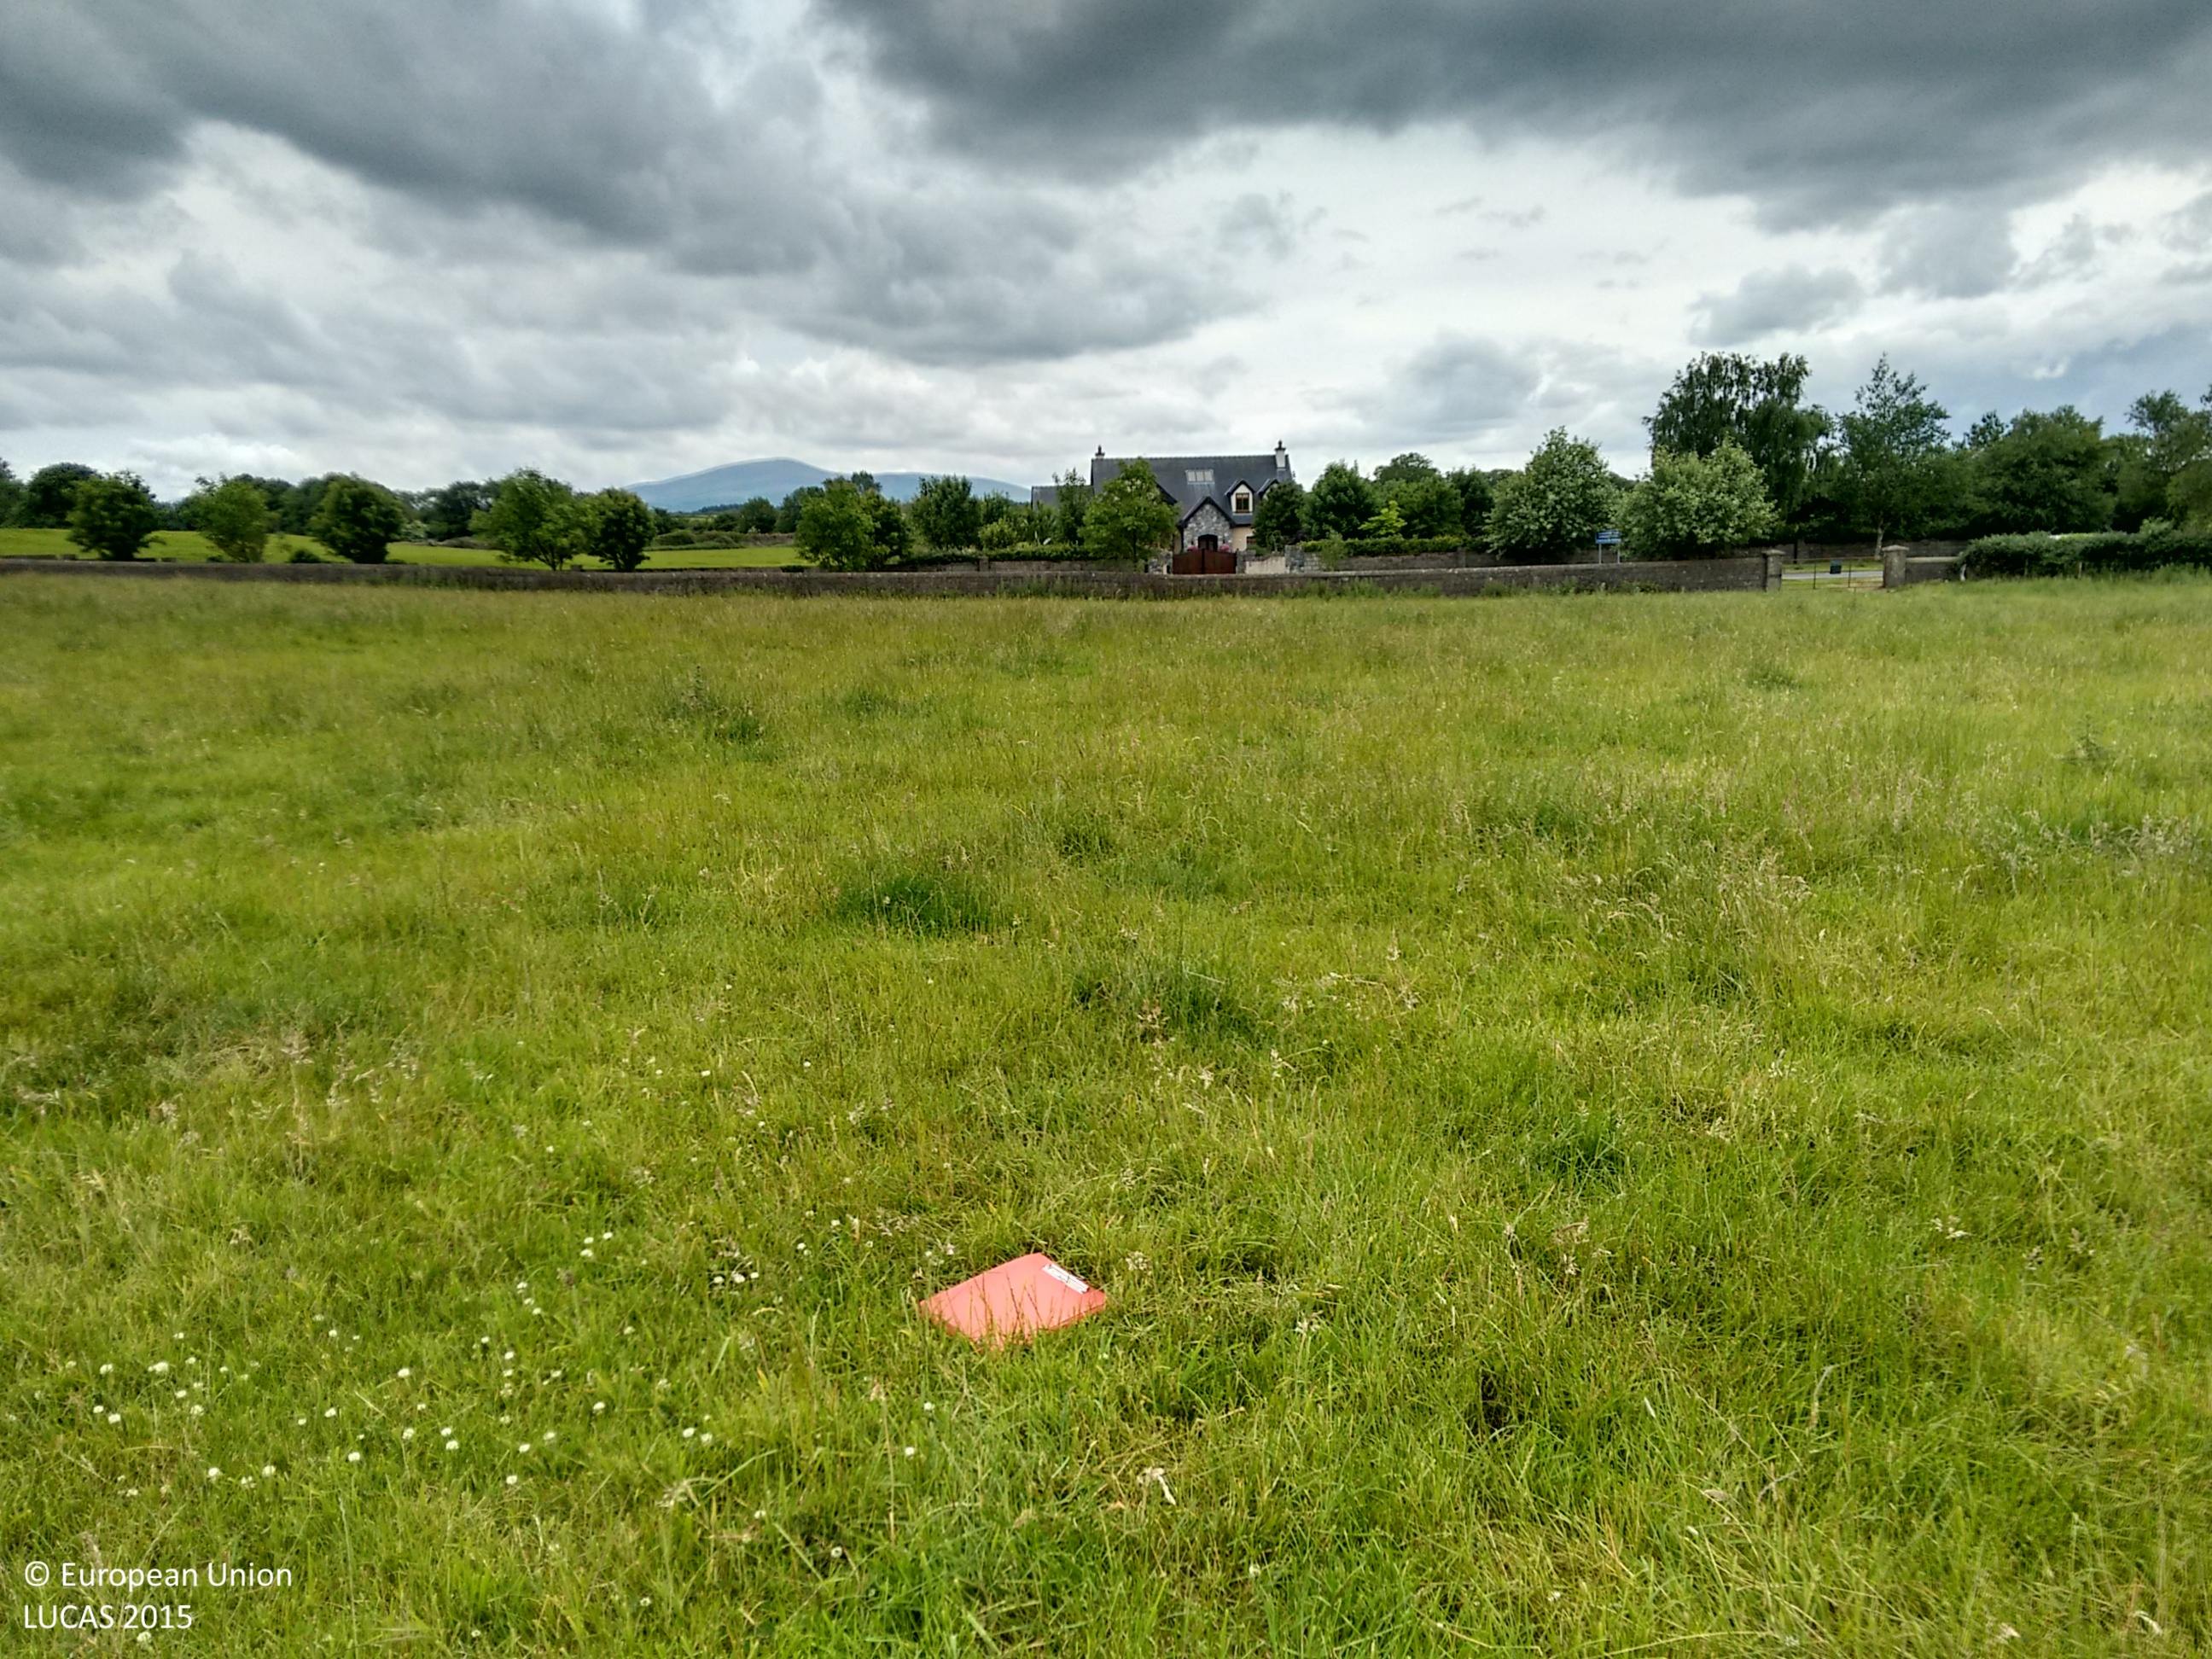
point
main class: Grassland
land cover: Grassland without tree/shrub cover
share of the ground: > 75 %
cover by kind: herbaceous plants 100 %
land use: Agriculture (excluding fallow land and kitchen gardens)
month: July
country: IE
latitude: 52.5518
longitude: -7.3961
